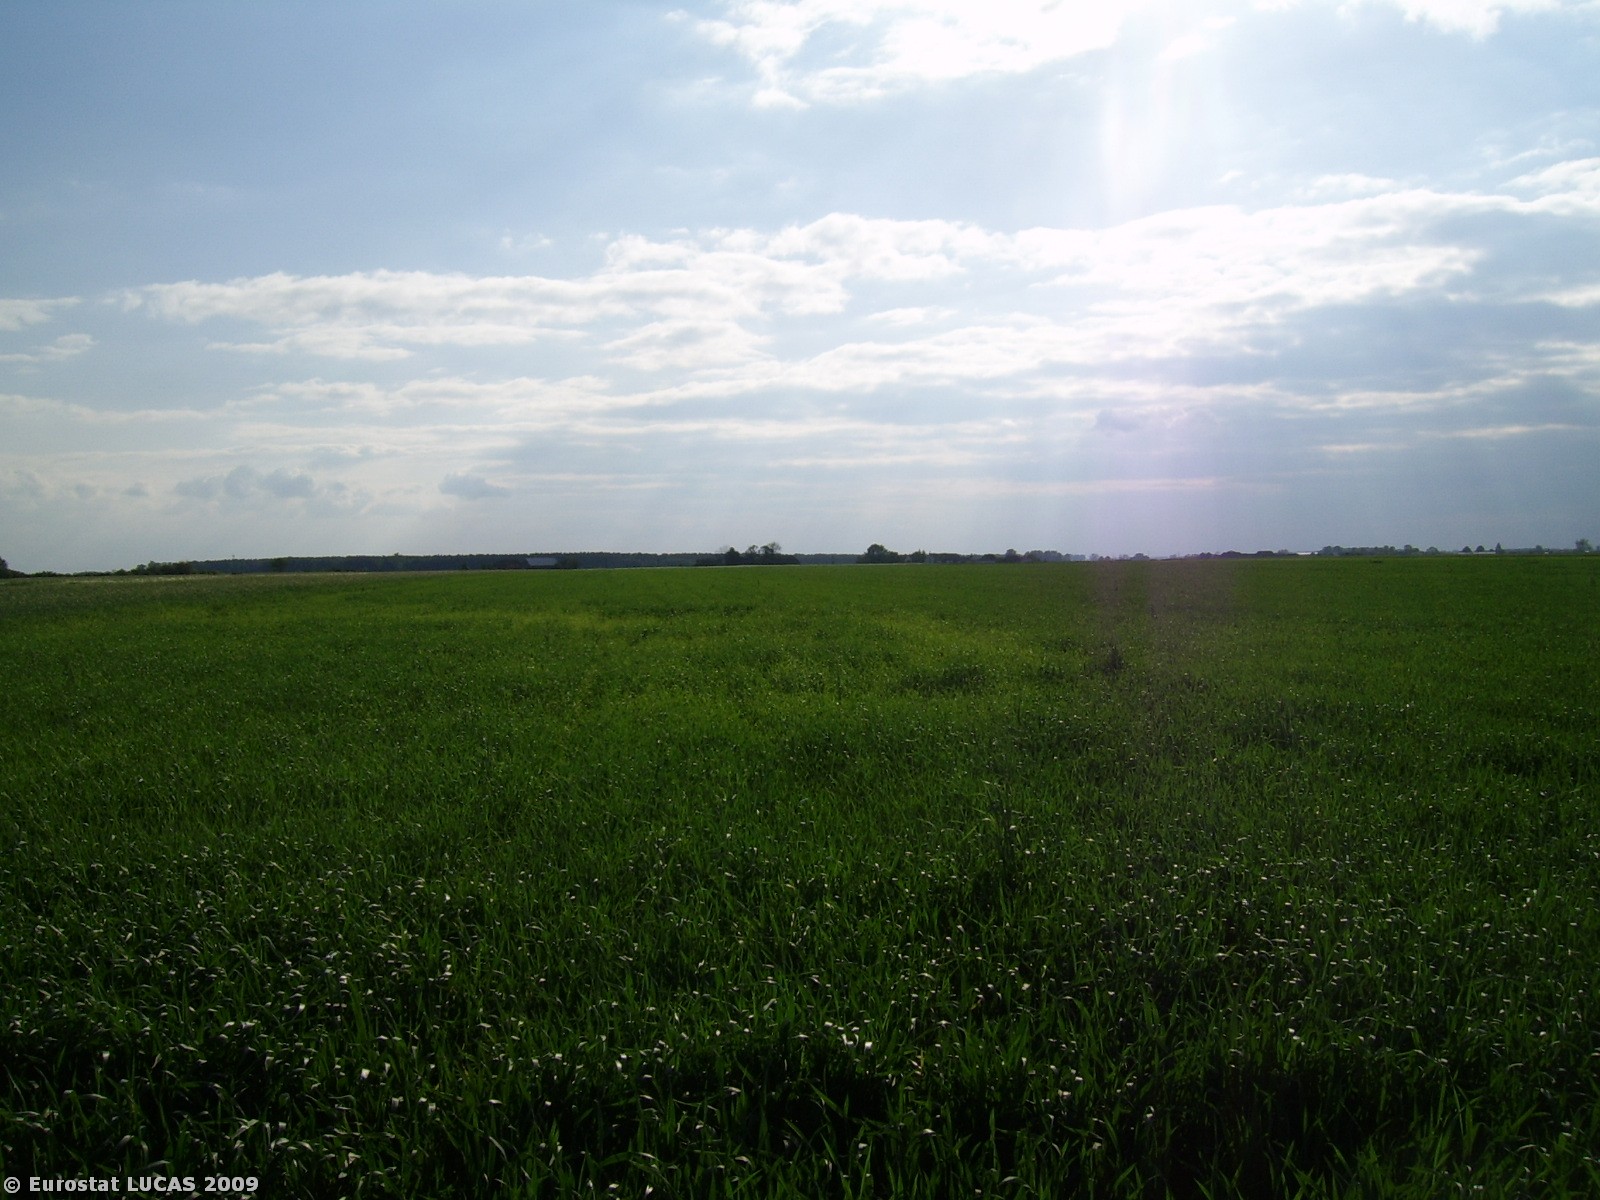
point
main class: Cropland
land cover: Triticale
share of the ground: > 75 %
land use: Agriculture (excluding fallow land and kitchen gardens)
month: May
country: PL
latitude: 51.8890
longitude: 16.8821
